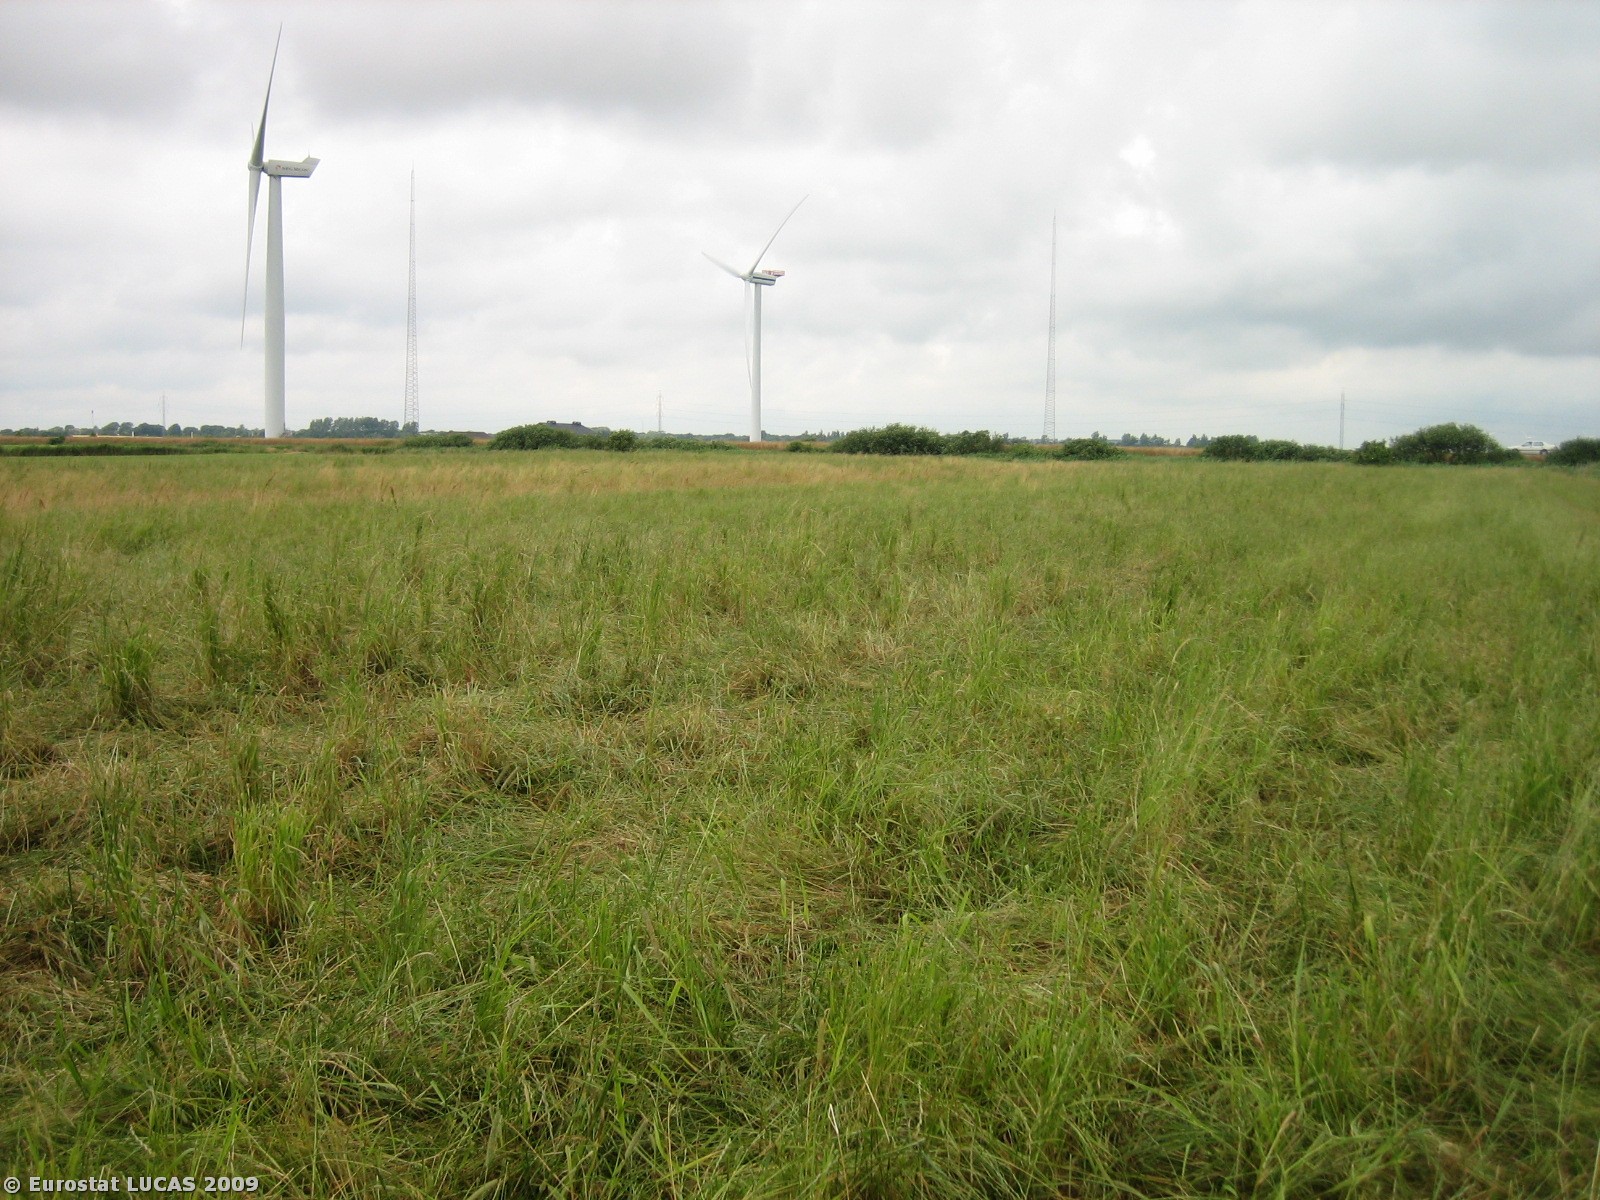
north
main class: Grassland
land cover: Grassland without tree/shrub cover
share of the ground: > 75 %
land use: Agriculture (excluding fallow land and kitchen gardens)
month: July
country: DK
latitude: 55.4430
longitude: 8.5943
